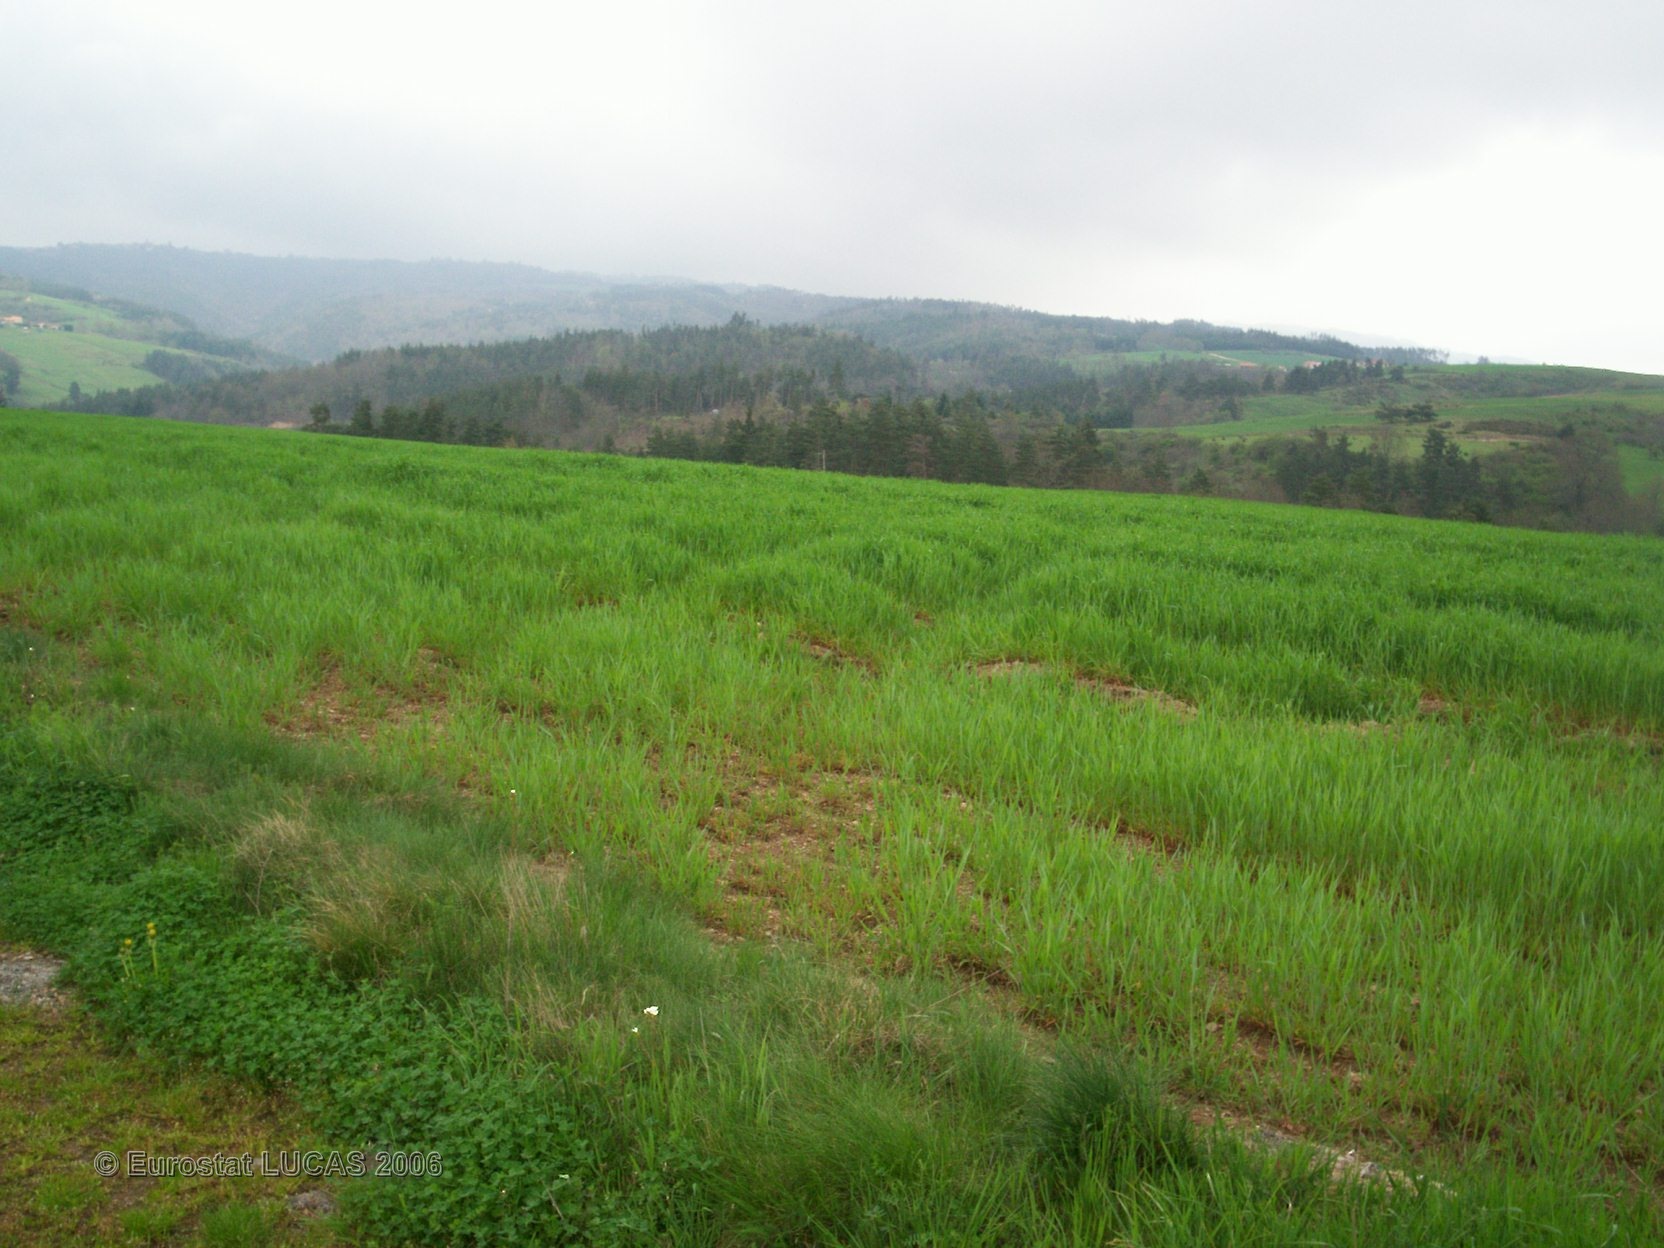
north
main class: Cropland
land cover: Rye
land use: Agriculture (excluding fallow land and kitchen gardens)
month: April
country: FR
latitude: 45.3434
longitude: 4.1714
